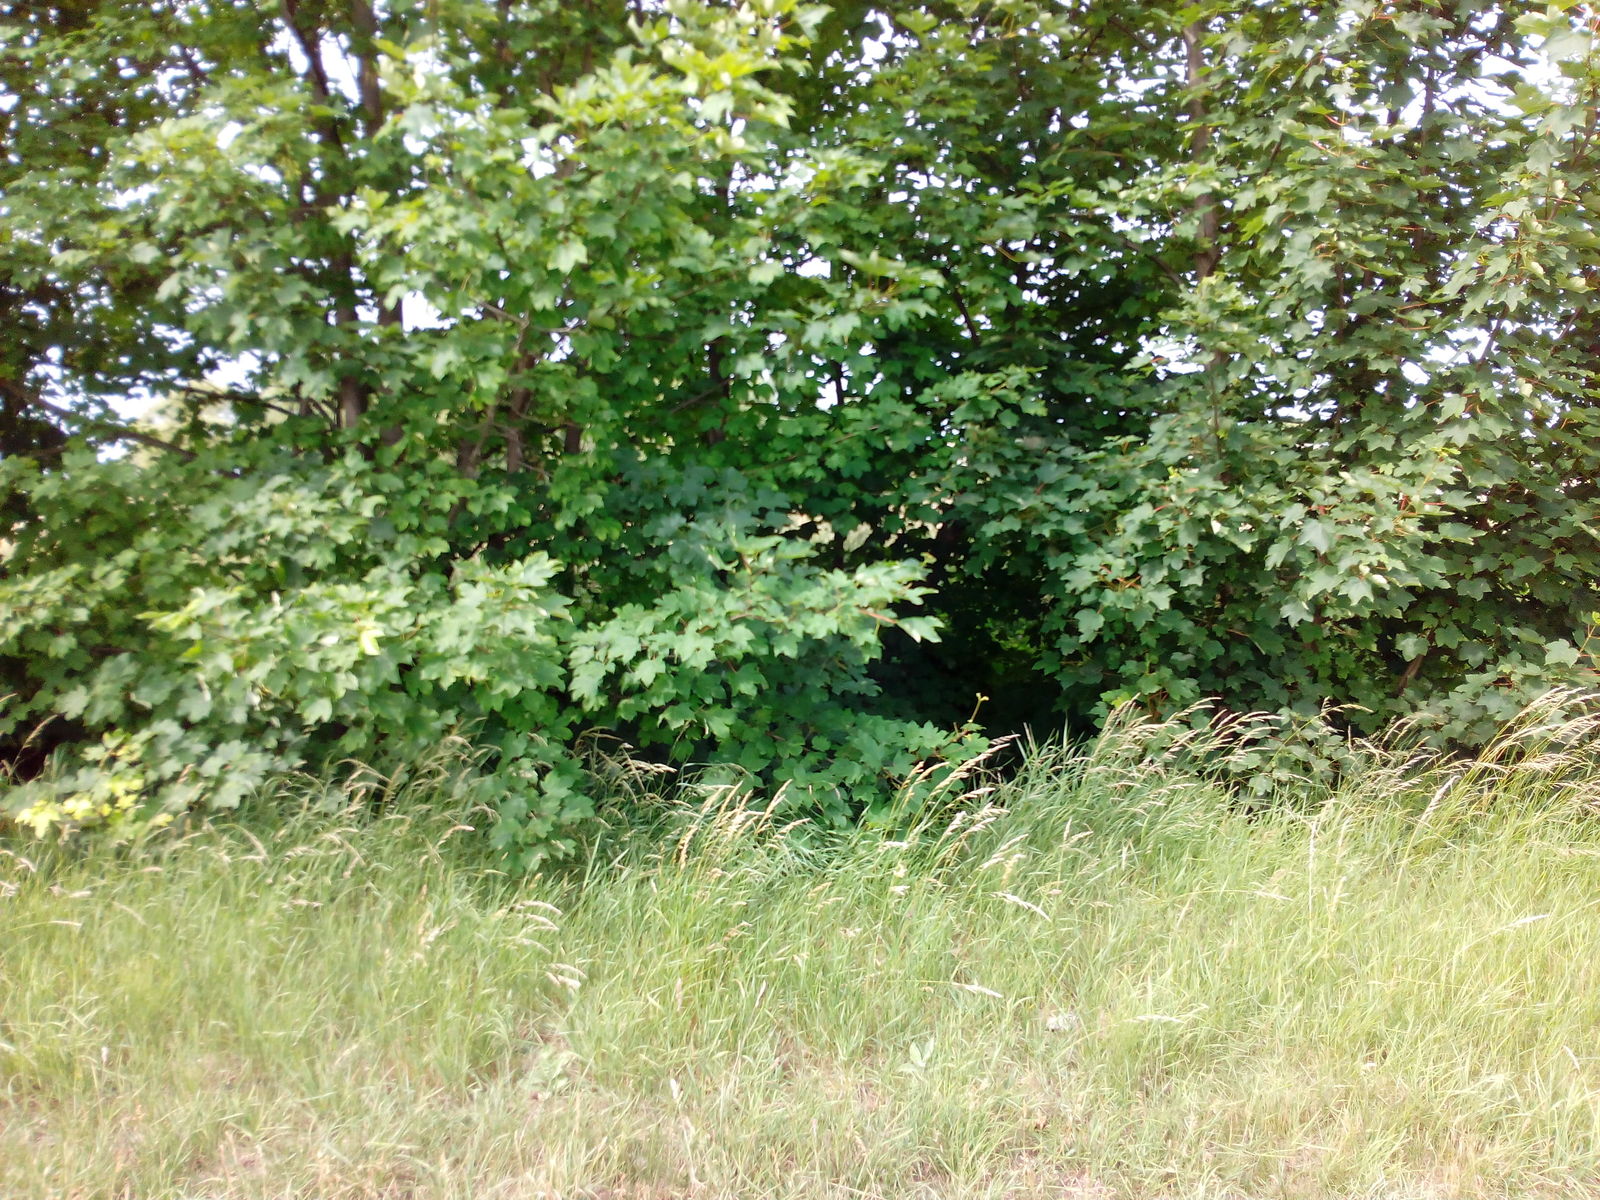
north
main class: Cropland
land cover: Sugar beet
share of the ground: > 75 %
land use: Agriculture (excluding fallow land and kitchen gardens)
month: June
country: DE
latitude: 51.2233
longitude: 10.9305
